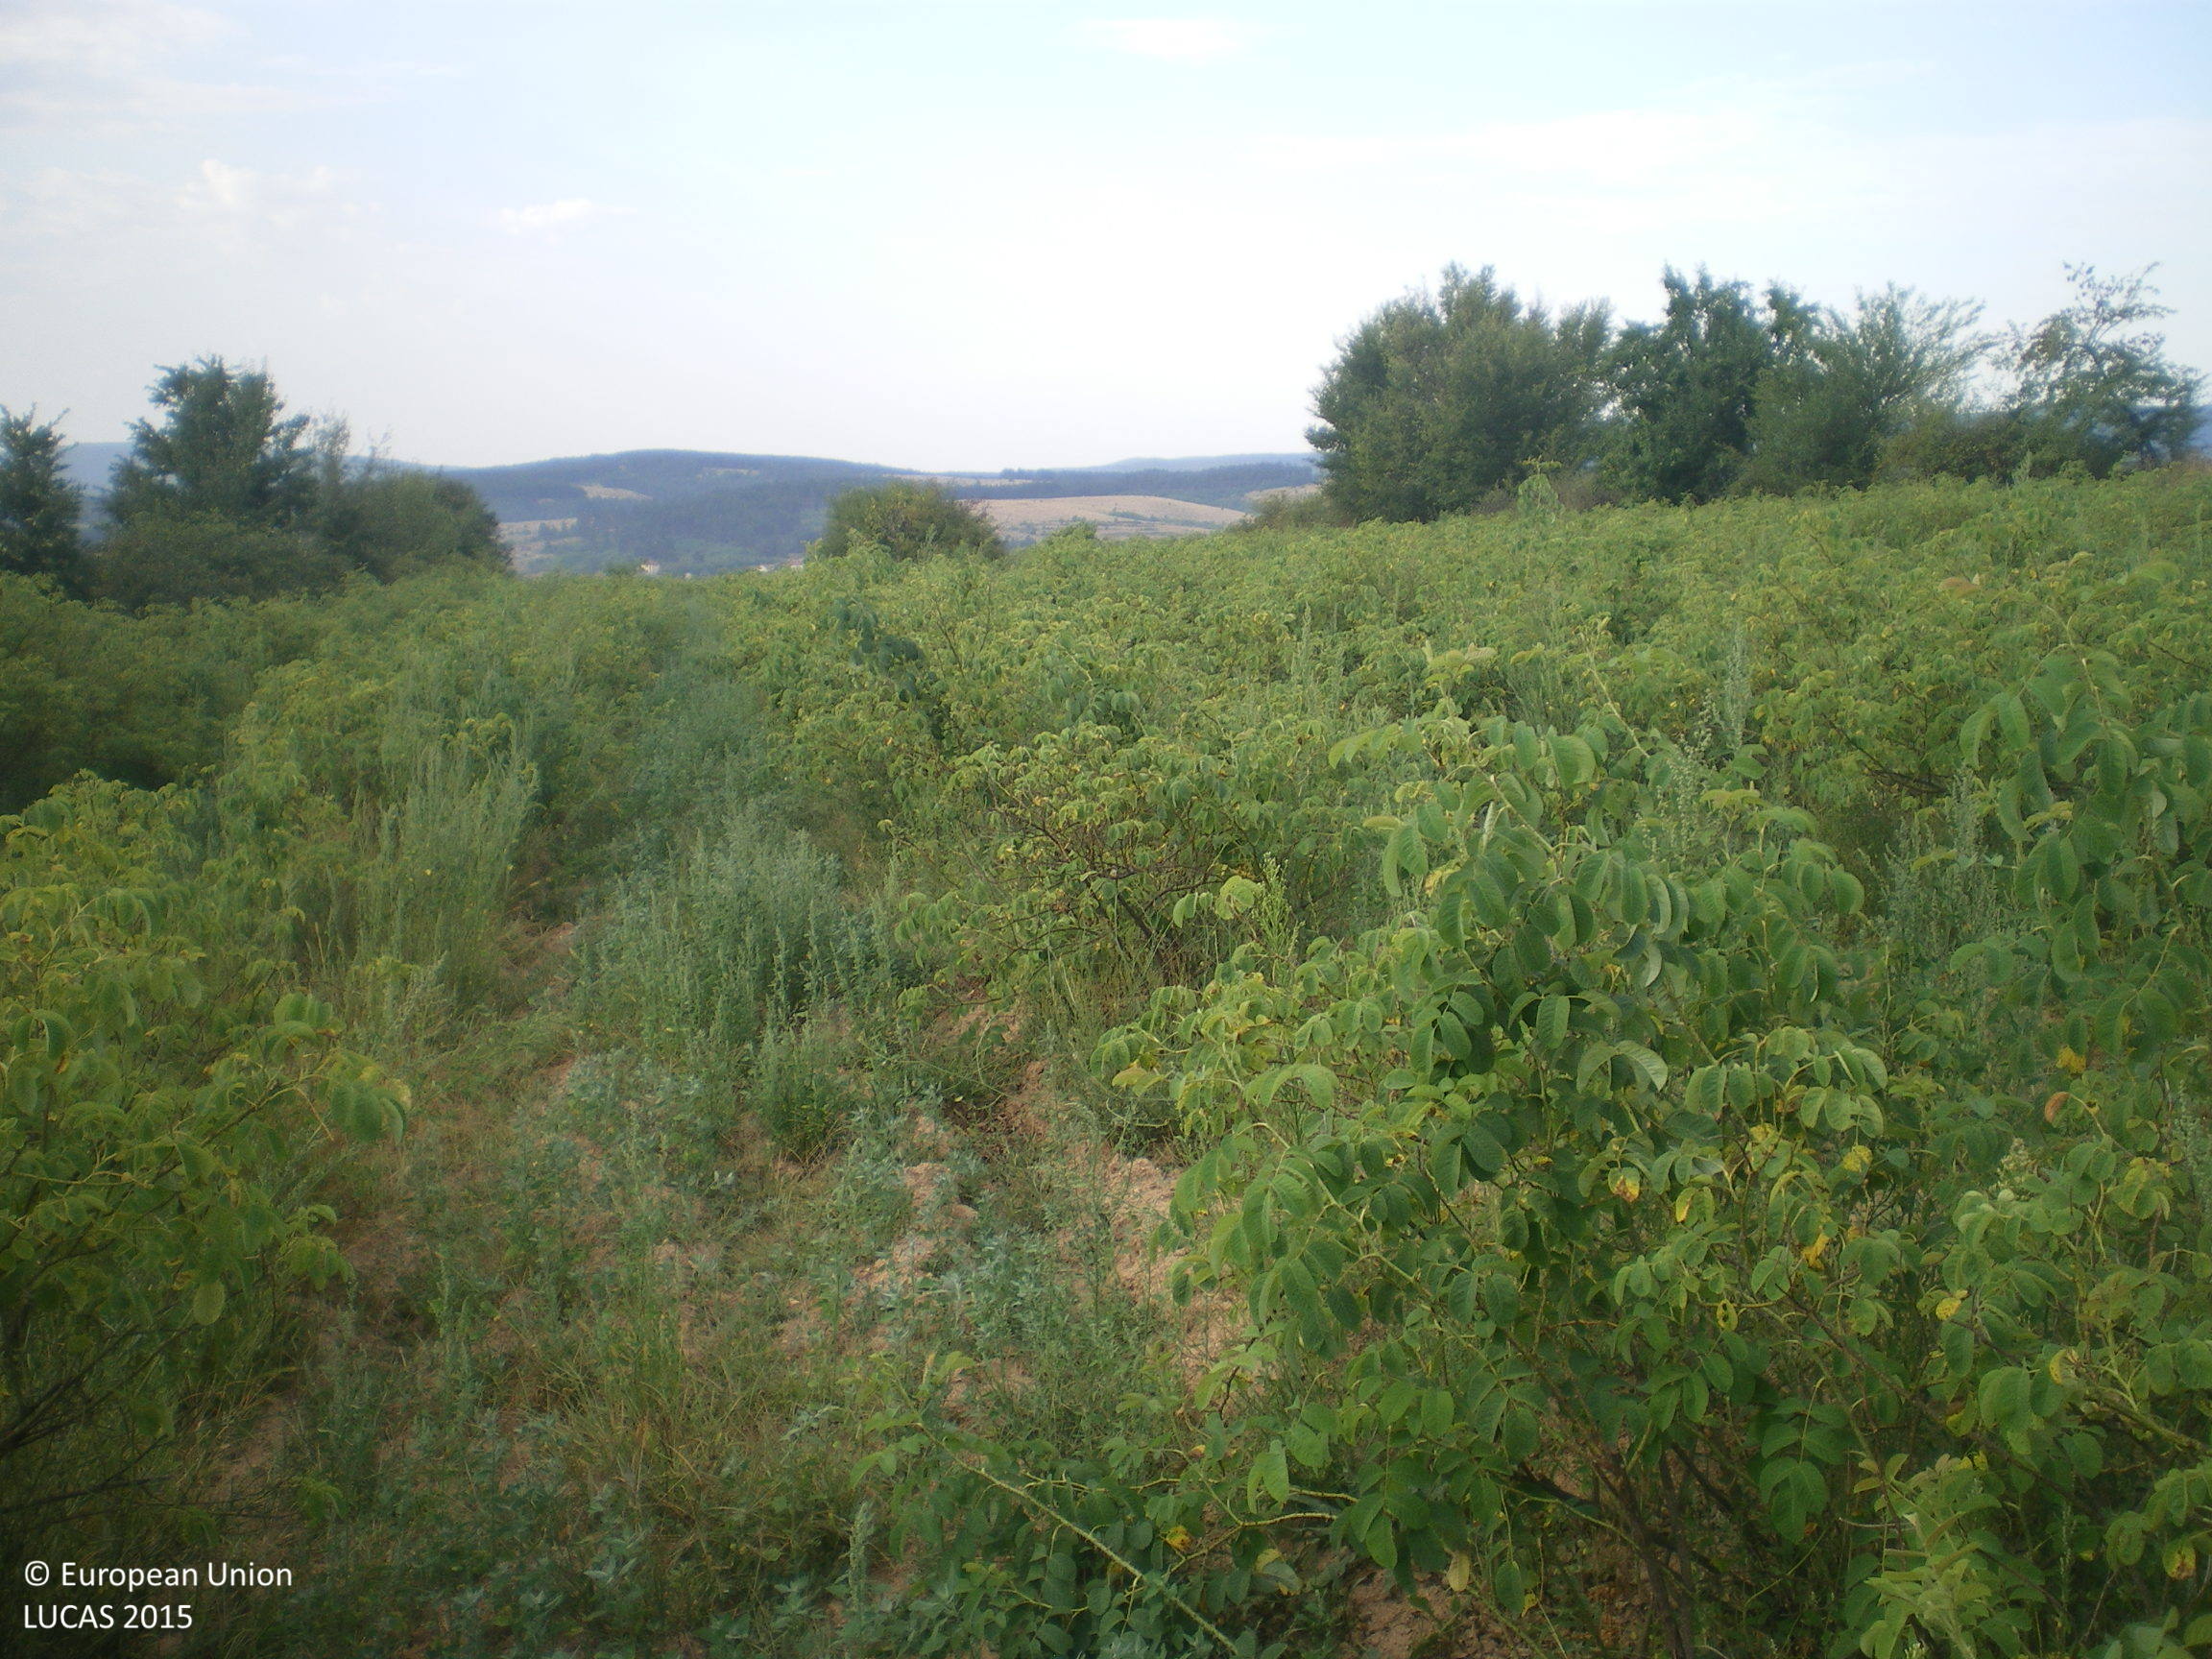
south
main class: Cropland
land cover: Permanent industrial crops
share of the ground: 50 - 75 %
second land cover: Spontaneously vegetated surfaces
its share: 25 - 50 %
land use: Agriculture (excluding fallow land and kitchen gardens)
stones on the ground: < 10 %
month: August
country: BG
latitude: 42.5829
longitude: 25.3102
